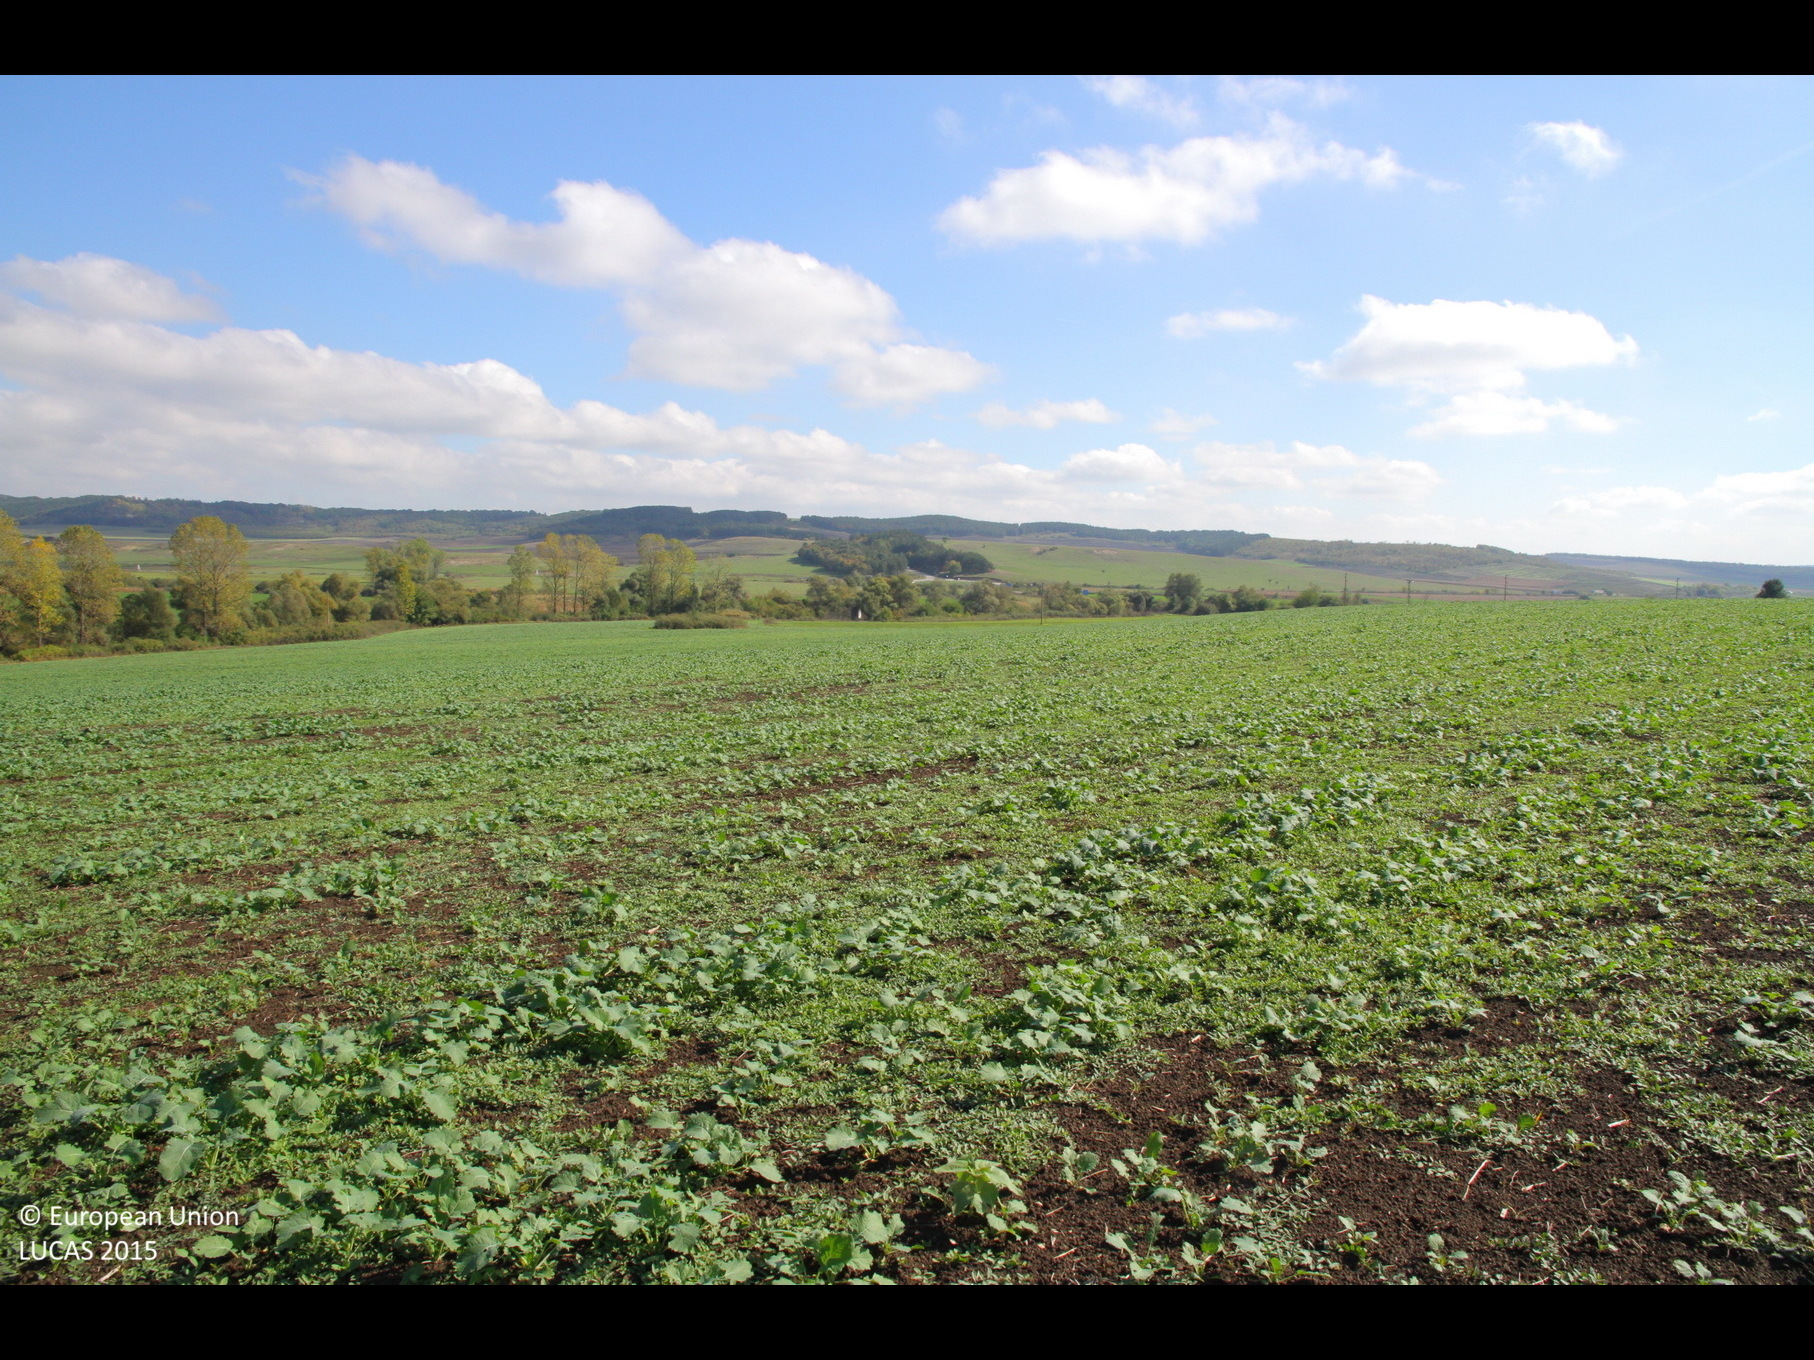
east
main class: Cropland
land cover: Rape and turnip rape
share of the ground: 25 - 50 %
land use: Agriculture (excluding fallow land and kitchen gardens)
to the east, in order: Rape and turnip rape
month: October
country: BG
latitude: 43.3633
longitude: 26.5278
